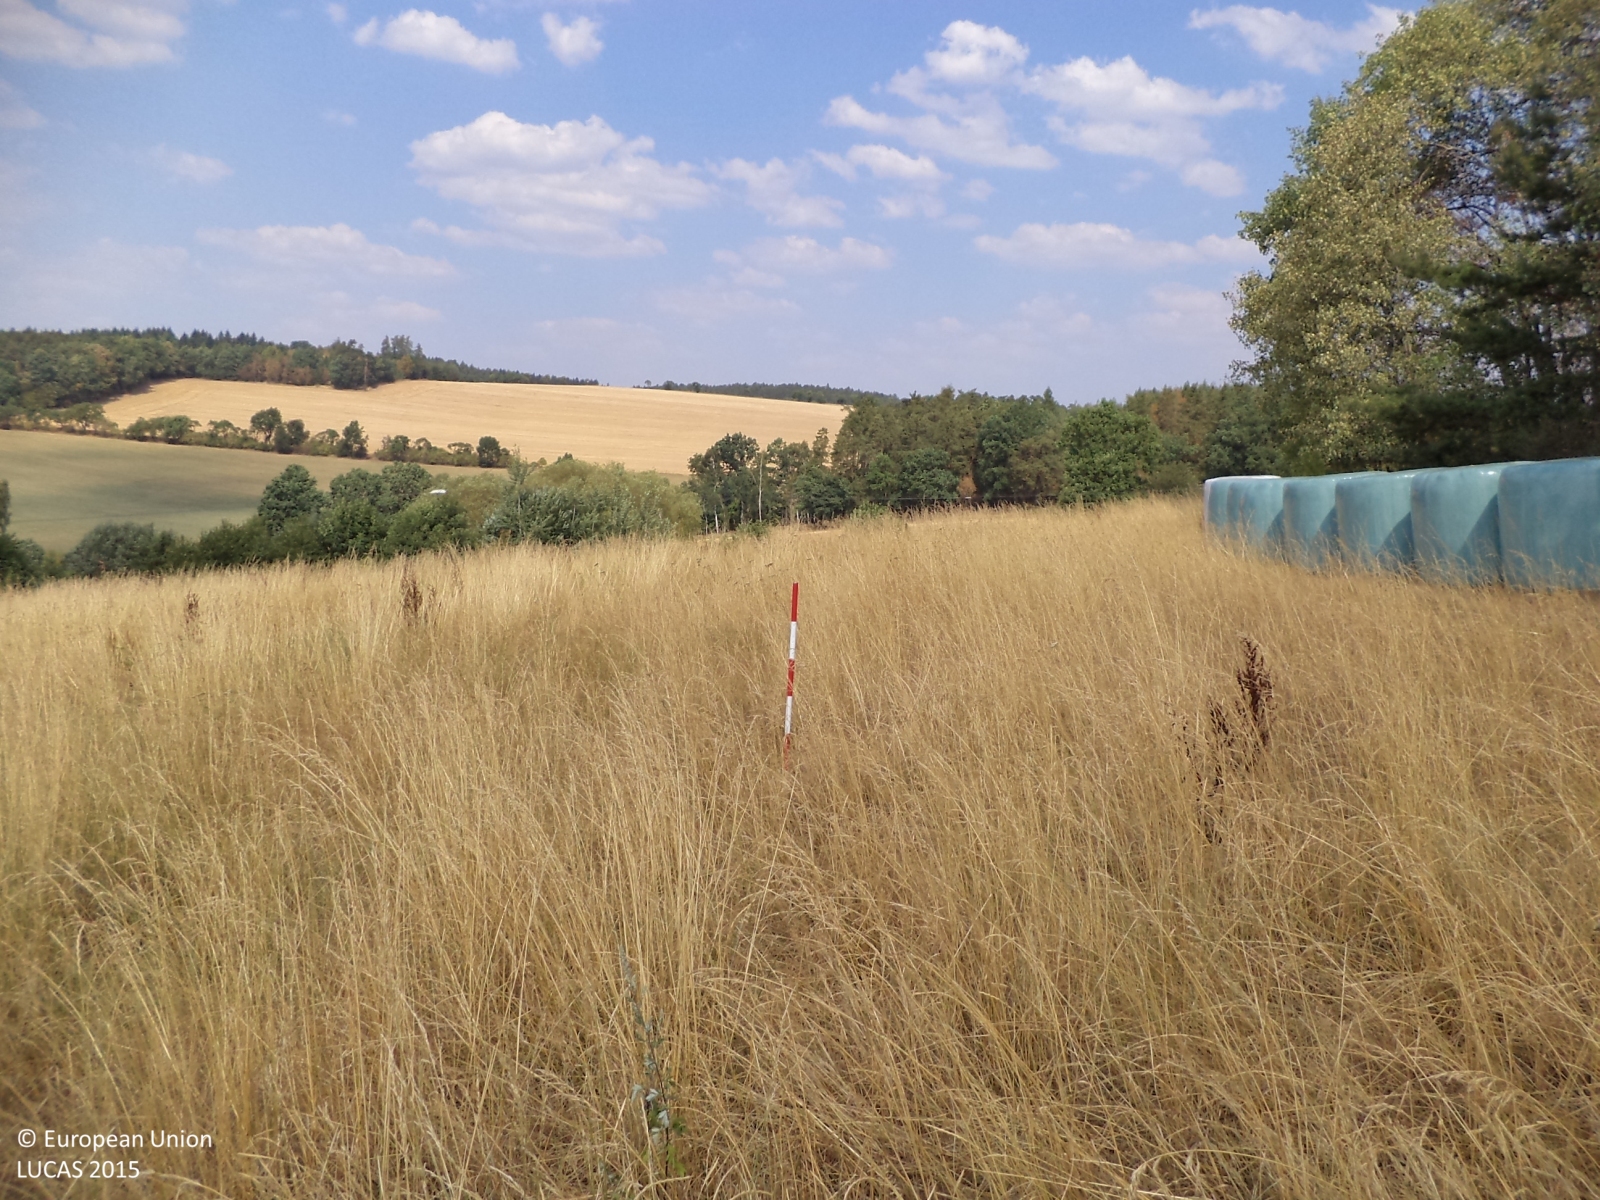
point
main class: Grassland
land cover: Grassland without tree/shrub cover
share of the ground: > 75 %
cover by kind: herbaceous plants 100 %
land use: Agriculture (excluding fallow land and kitchen gardens)
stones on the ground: < 10 %
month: August
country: CZ
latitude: 49.7326
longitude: 14.5663
